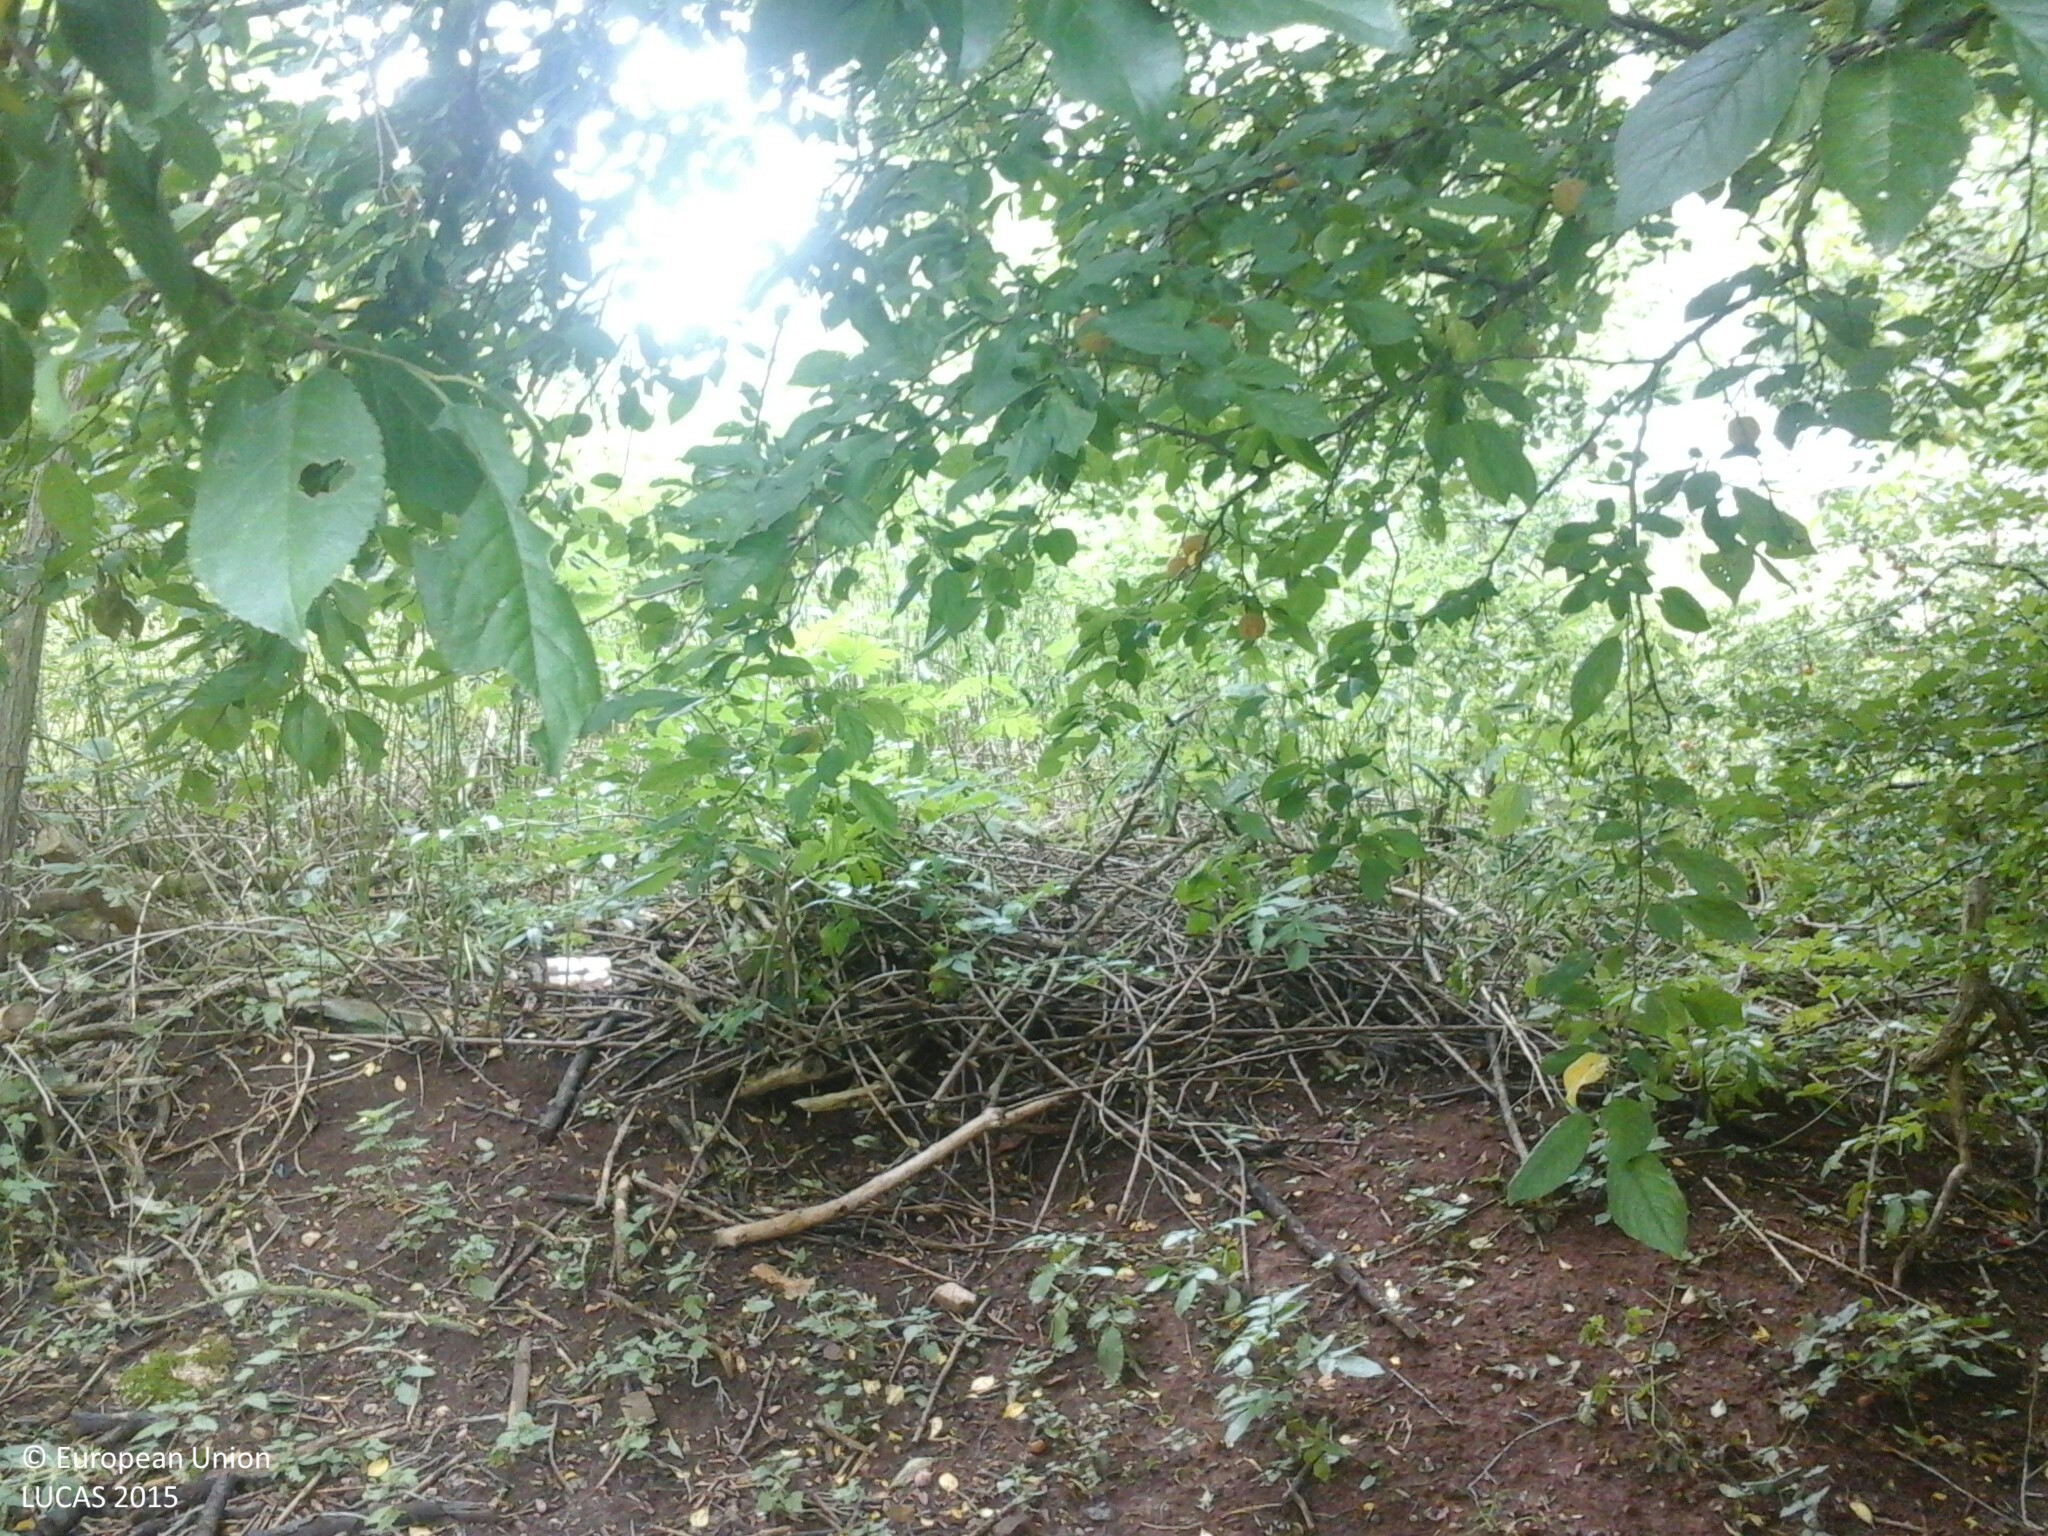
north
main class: Shrubland
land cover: Shrubland with sparse tree cover
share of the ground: > 75 %
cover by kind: shrubs 75 %, herbaceous plants 20 %, broadleaved forest trees 5 %
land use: Abandoned areas
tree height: > 5 m
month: July
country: HU
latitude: 46.9787
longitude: 17.9357
